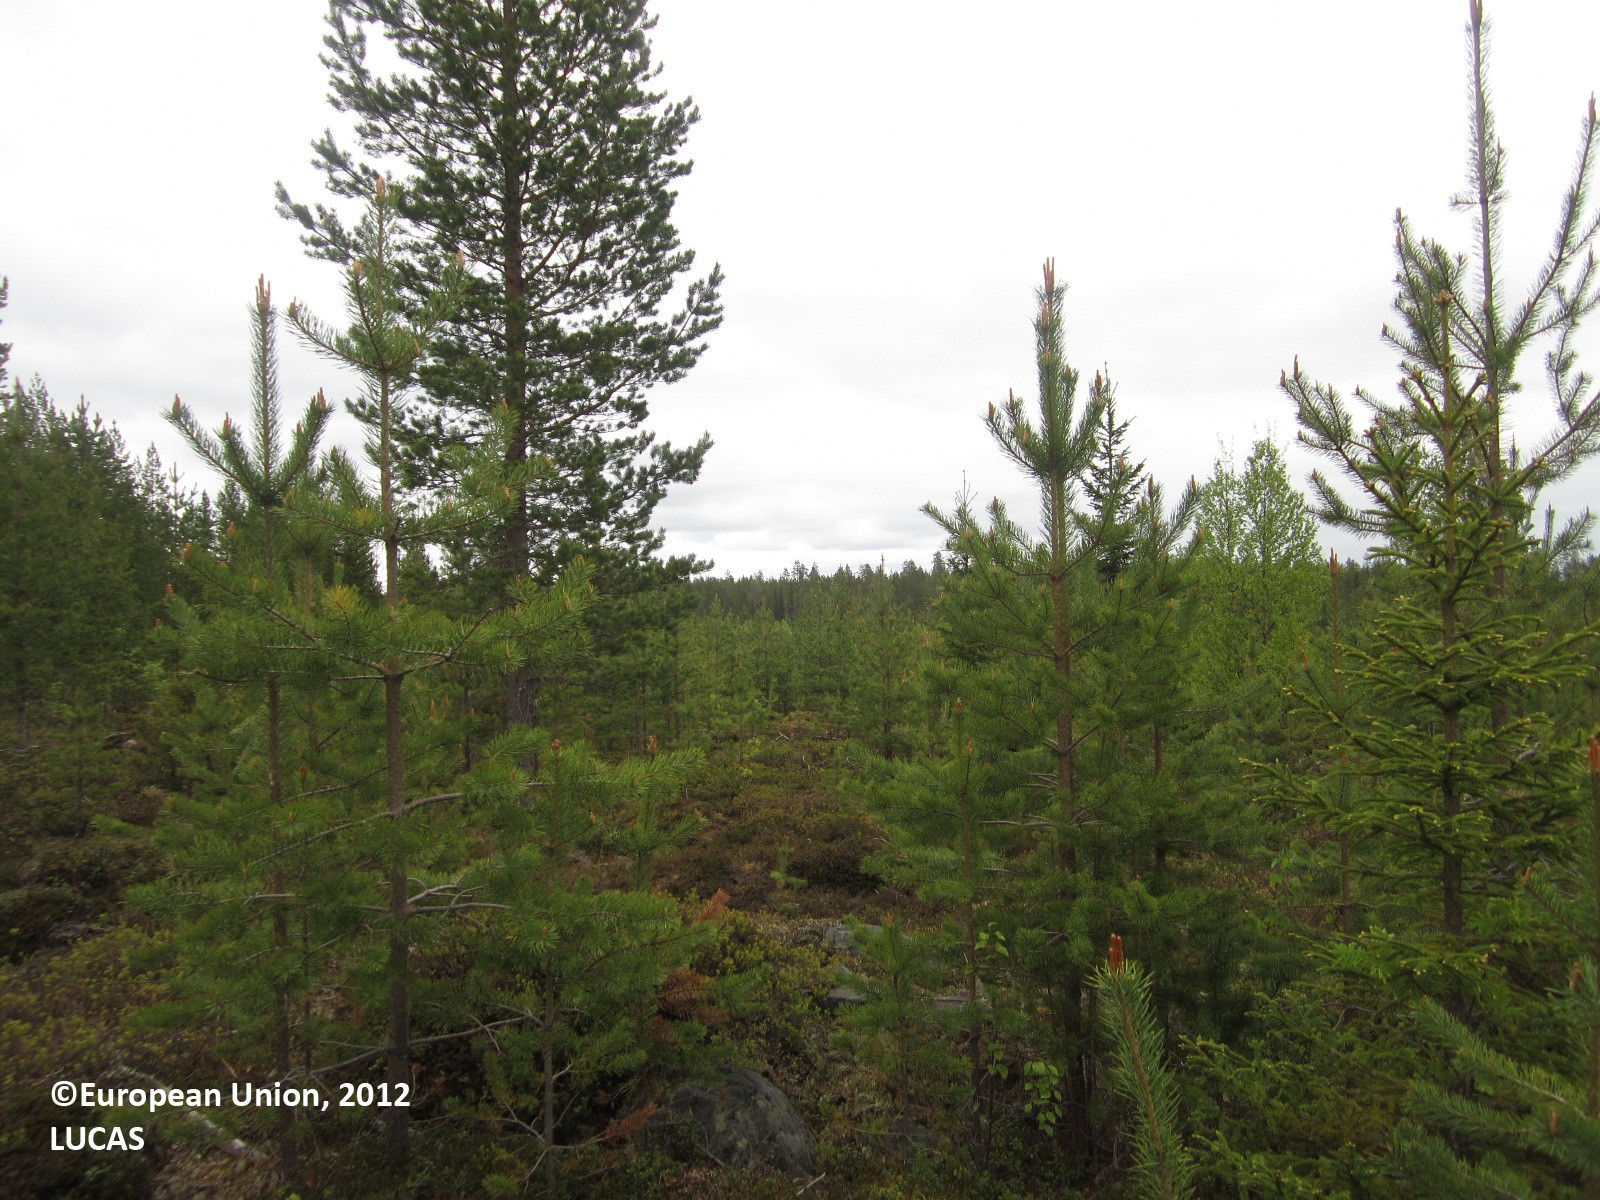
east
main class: Woodland
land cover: Pine dominated coniferous woodland
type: boreal forest
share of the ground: 10 - 25 %
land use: Forestry
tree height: < 5 m
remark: Clear cut
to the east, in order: Pine dominated coniferous woodland; Pine dominated mixed woodland; Grassland without tree/shrub cover; Pine dominated mixed woodland
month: June
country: FI
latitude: 64.7459
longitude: 28.8610
